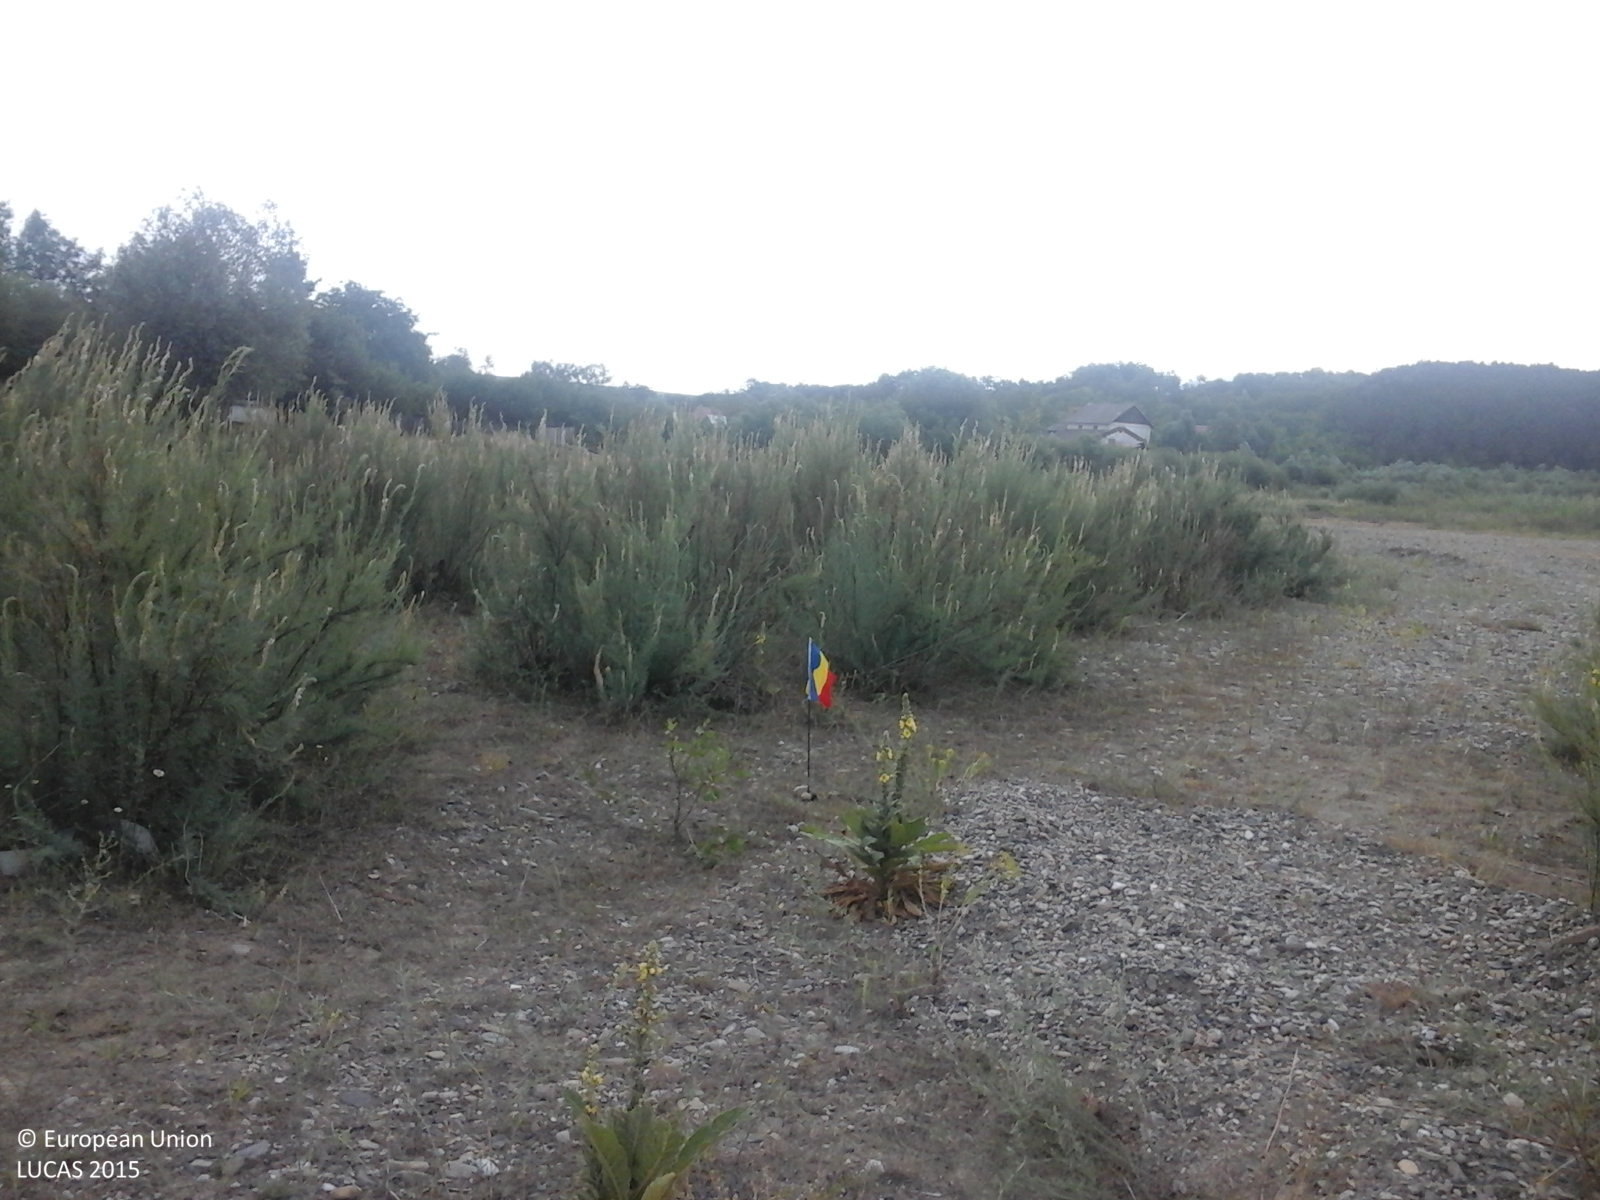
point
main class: Grassland
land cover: Spontaneously vegetated surfaces
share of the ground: 25 - 50 %
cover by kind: unconsolidated bare surface 50 %, herbaceous plants 45 %, shrubs 5 %
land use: Semi-natural and natural areas not in use
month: June
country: RO
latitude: 47.3033
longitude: 26.4739
